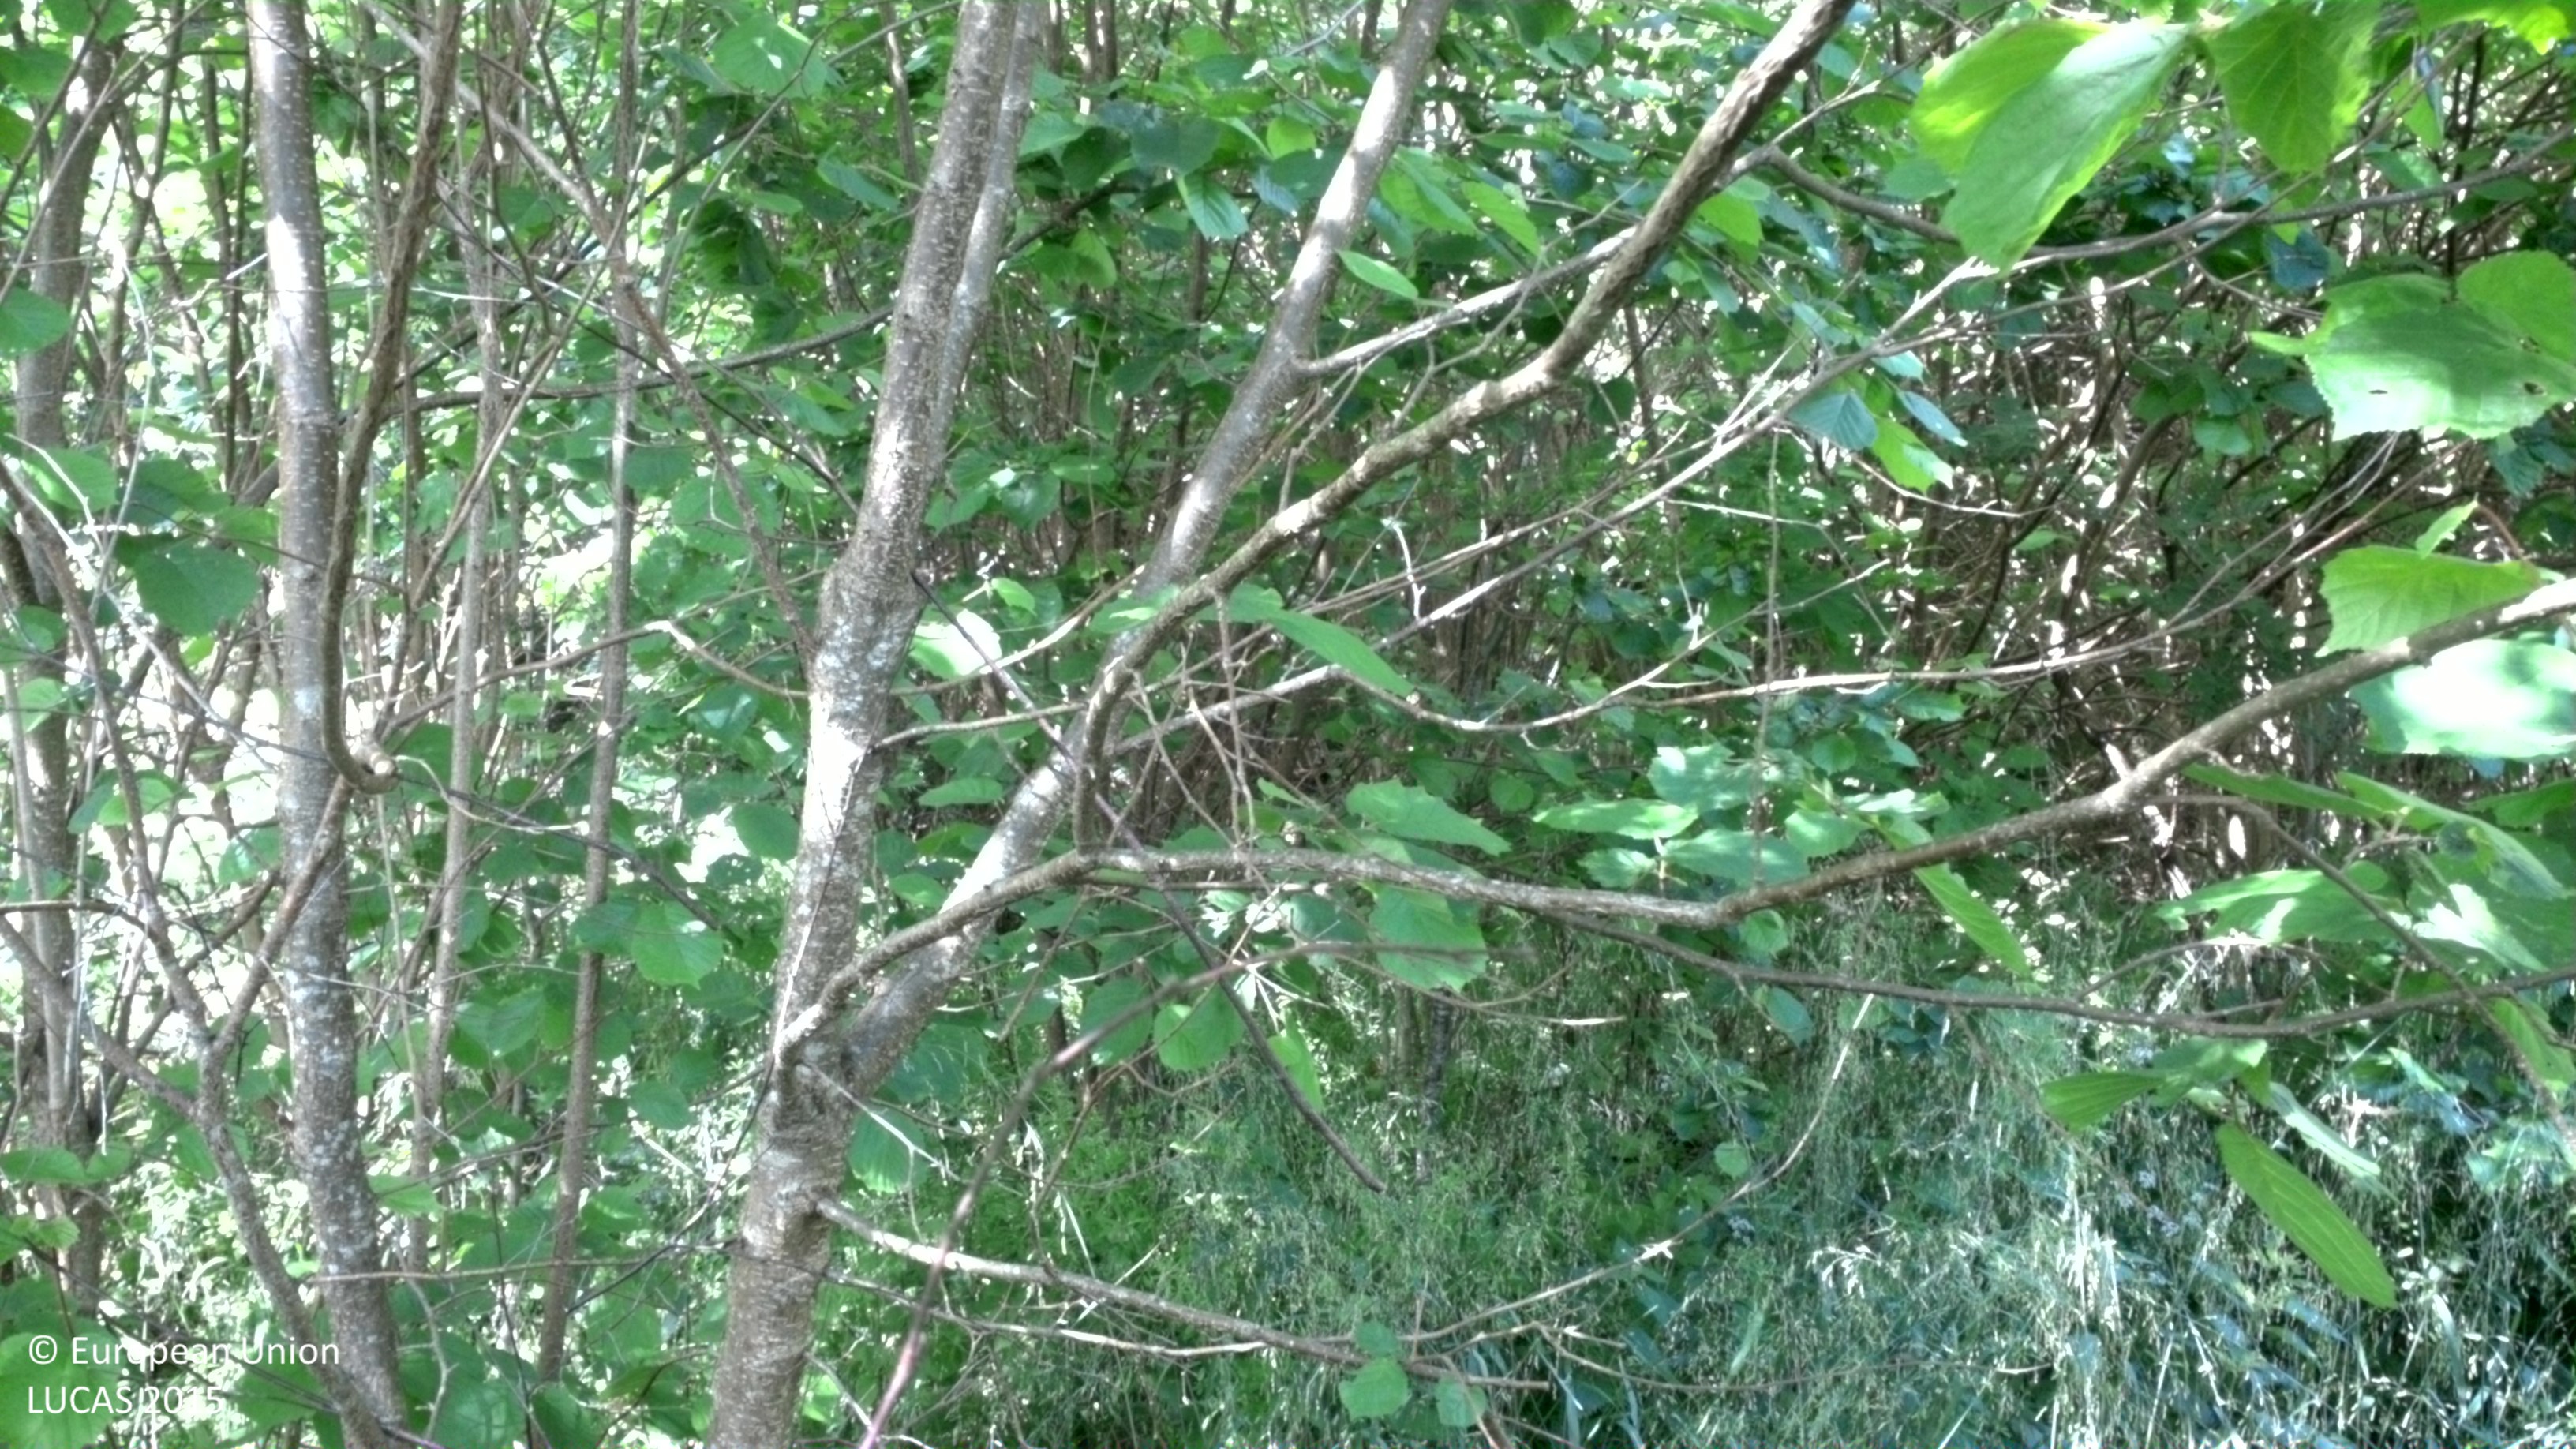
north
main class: Woodland
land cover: Broadleaved woodland
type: hemiboreal forest and nemoral coniferous forest and mixed broadleaved-coniferous forest
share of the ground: 25 - 50 %
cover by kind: shrubs 45 %, broadleaved forest trees 40 %, herbaceous plants 15 %
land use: Forestry
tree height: > 5 m
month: June
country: SE
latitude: 57.8918
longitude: 16.6615
